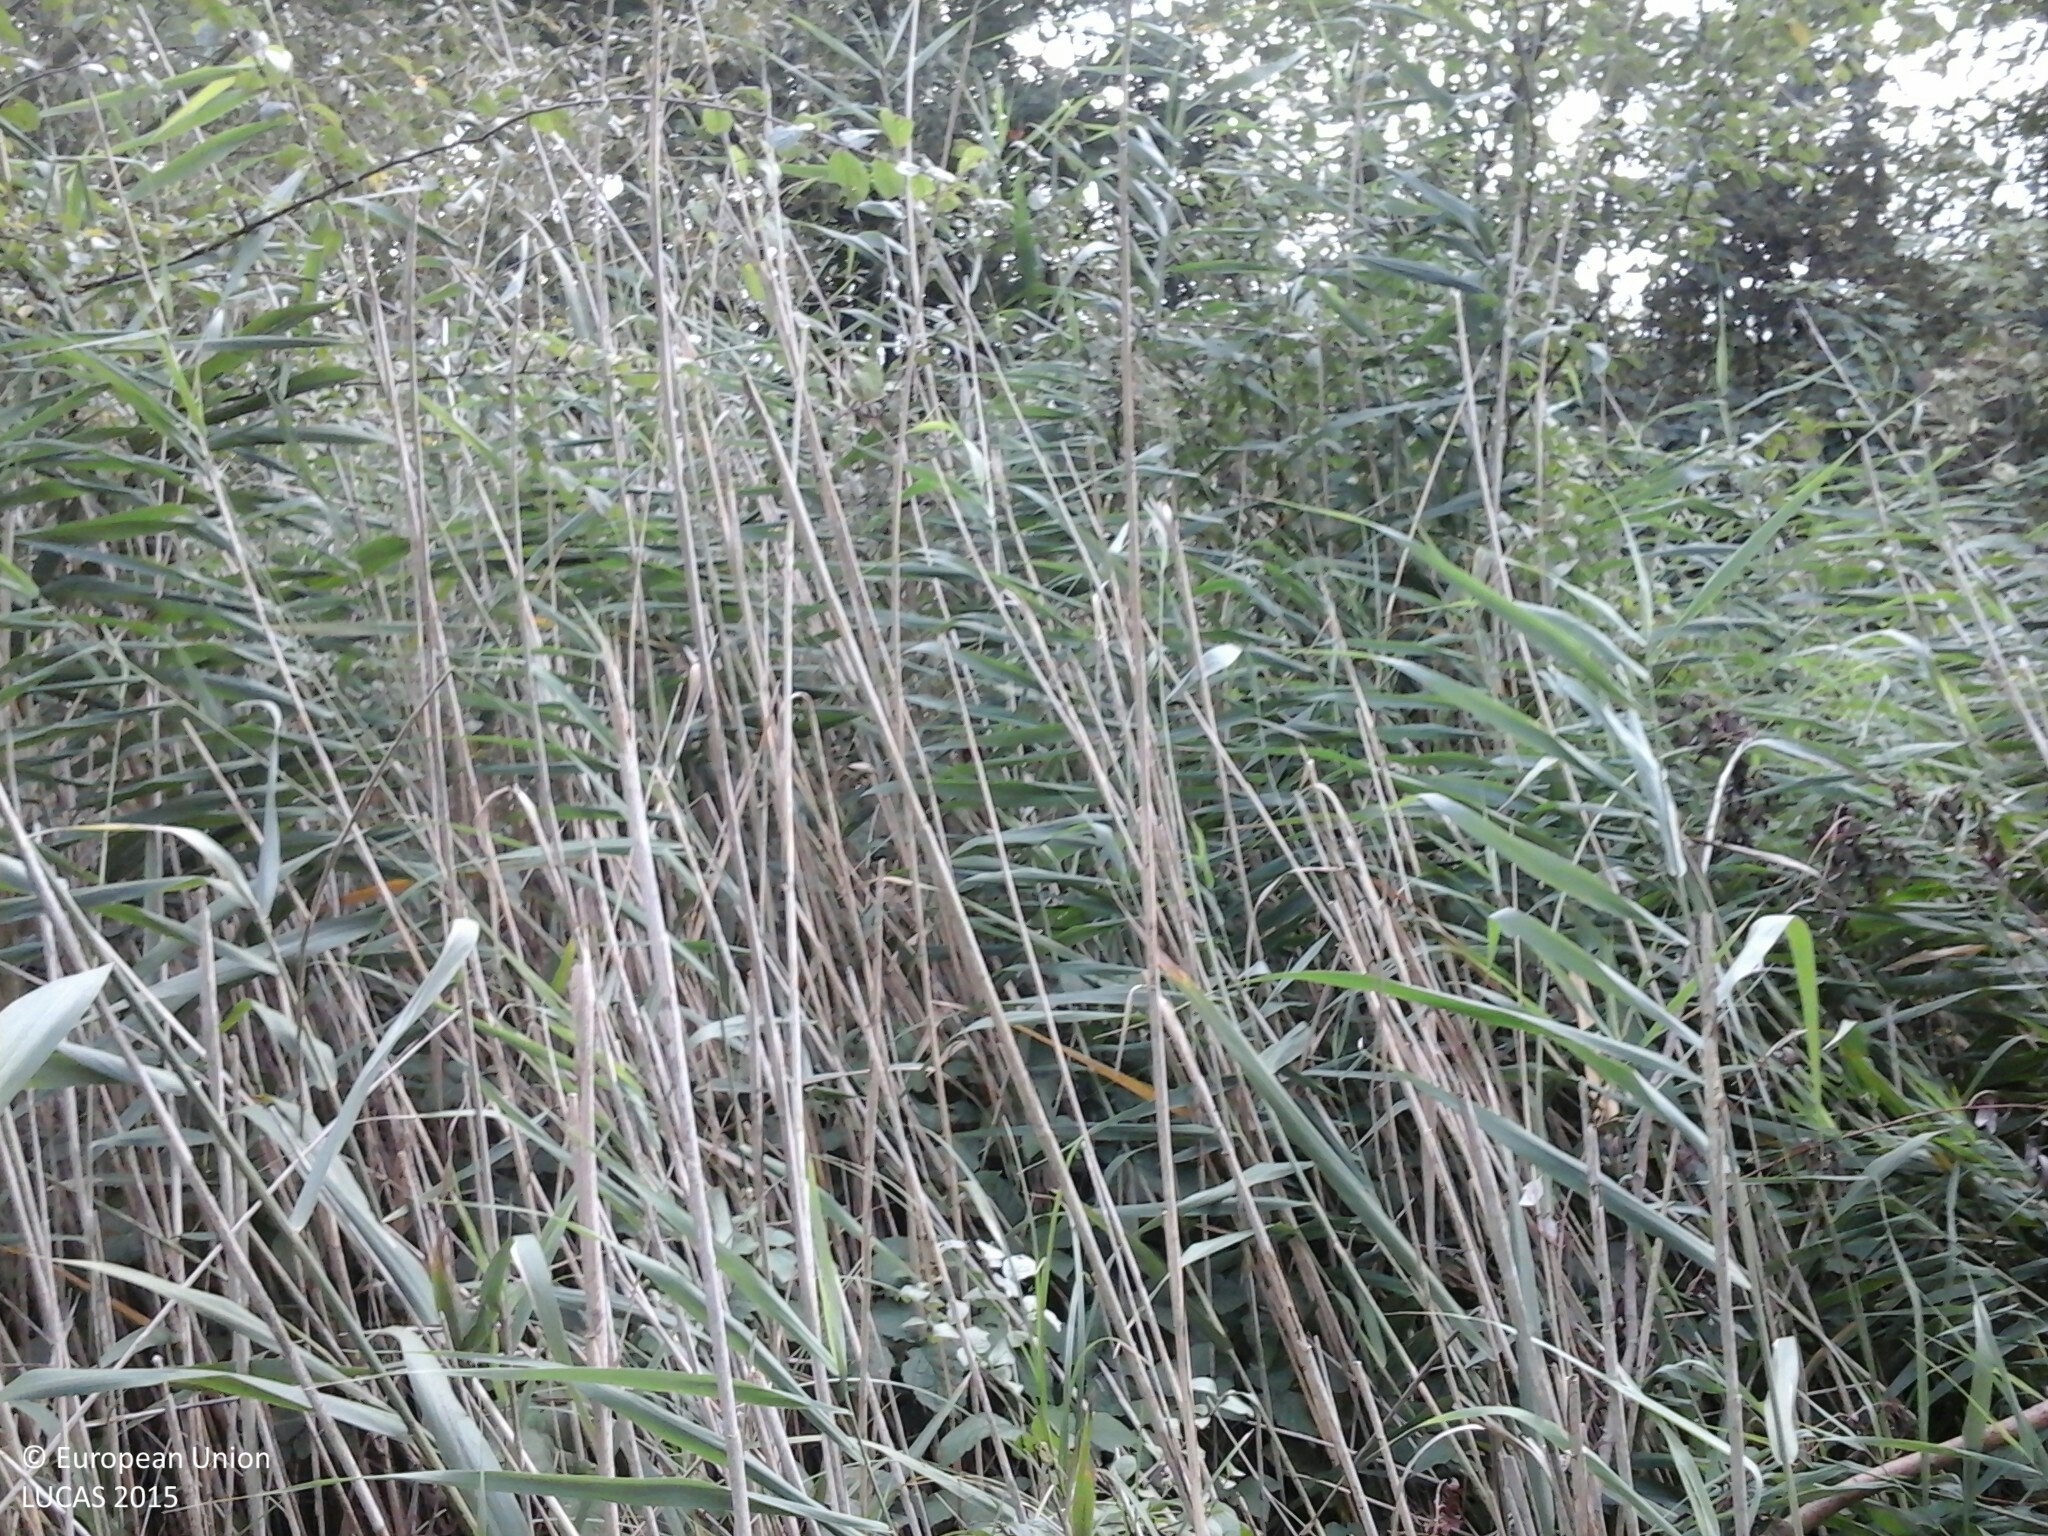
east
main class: Grassland
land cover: Grassland with sparse tree/shrub cover
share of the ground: > 75 %
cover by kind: herbaceous plants 85 %, shrubs 10 %, broadleaved forest trees 5 %
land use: Semi-natural and natural areas not in use
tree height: > 5 m
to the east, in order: Grassland with sparse tree/shrub cover; Broadleaved woodland; Railways; Grass margins; Artificial constructions in urban areas; Broadleaved woodland; Grassland with sparse tree/shrub cover; Grassland without tree/shrub cover; Artificial constructions in urban areas; Ditches and canals; Artificial constructions in urban areas; Lines of trees; Grassland with sparse tree/shrub cover
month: September
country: HU
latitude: 47.9835
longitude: 19.8203
